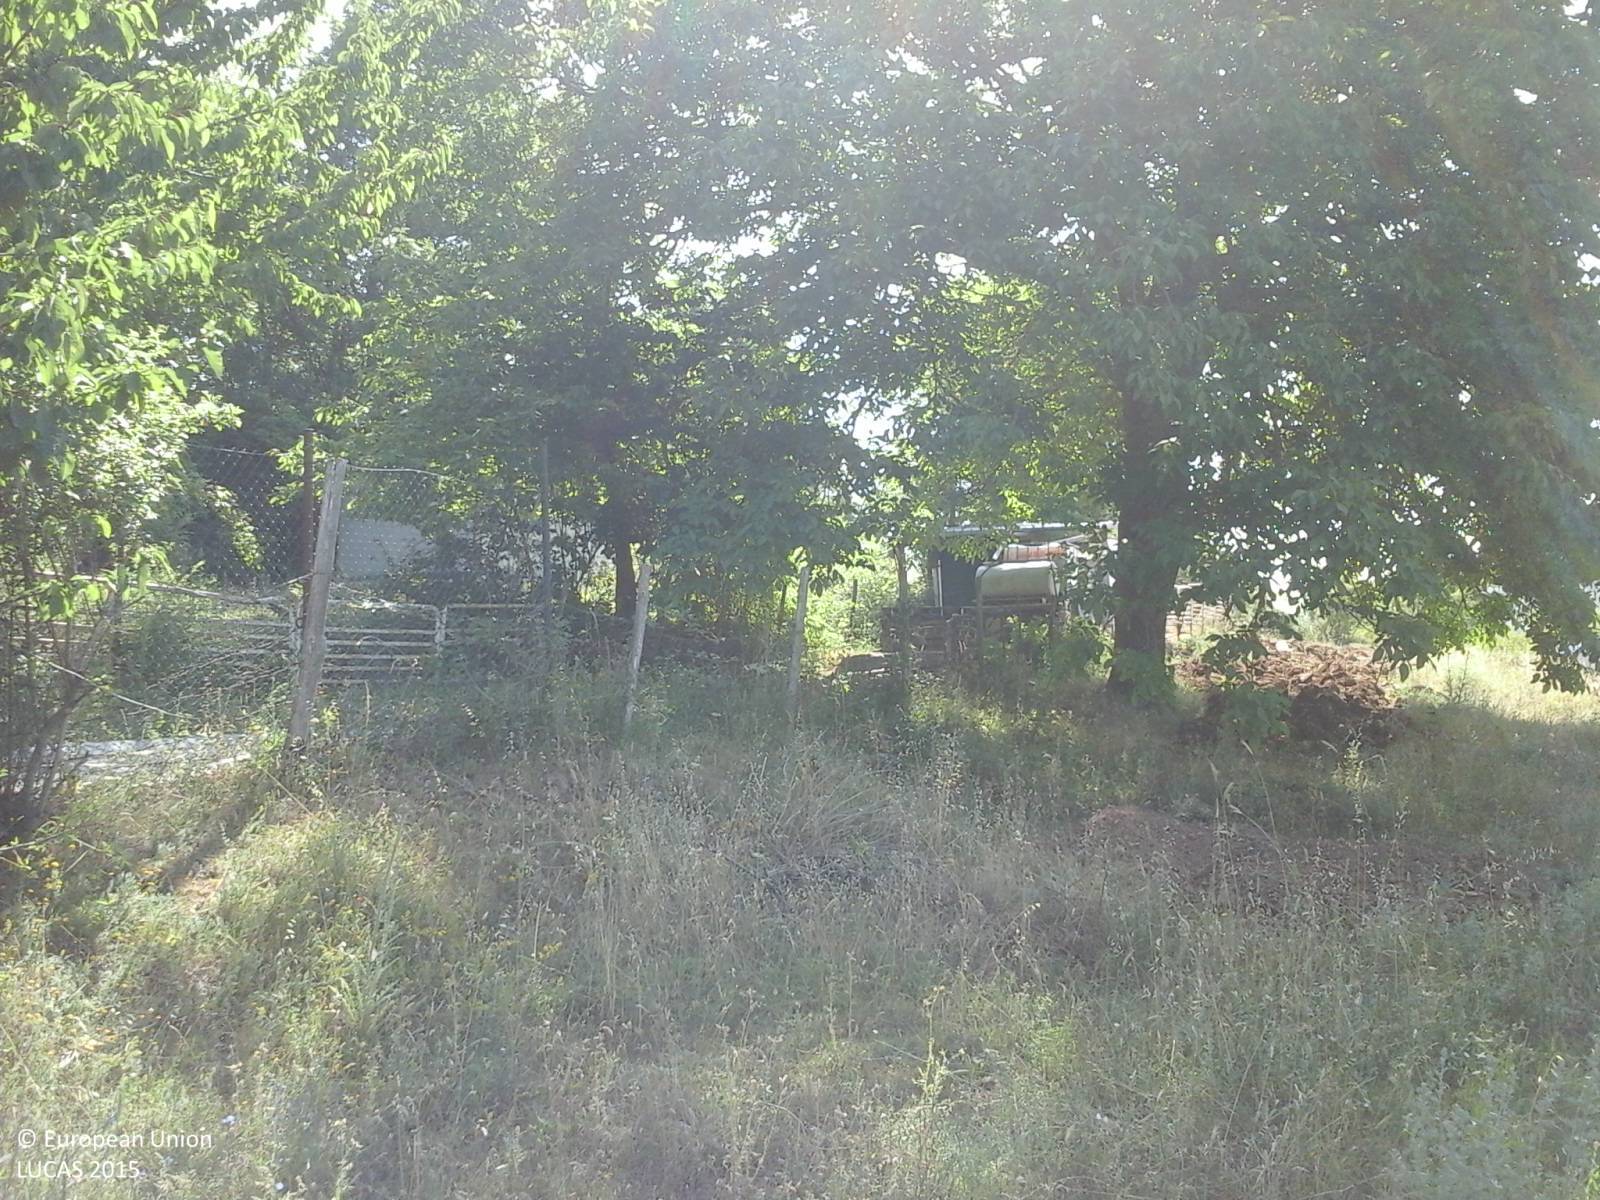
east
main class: Cropland
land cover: Lucerne
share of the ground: > 75 %
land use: Agriculture (excluding fallow land and kitchen gardens)
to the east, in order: Lucerne; Fences; Broadleaved woodland; Mixed cereals for fodder; Abandoned hedges; Grass margins; Paved roads, cycling and walking lanes; Grass margins; Fences; Dry pulses; Potatoes; Fences; Dry pulses; Fences; Tracks; Fences; Dry pulses; Fences; Lucerne; Fences; Vineyards; Abandoned hedges; Fences; Mixed cereals for fodder; Maize; Artificial constructions in urban areas
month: July
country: IT
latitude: 42.3964
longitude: 13.4513
